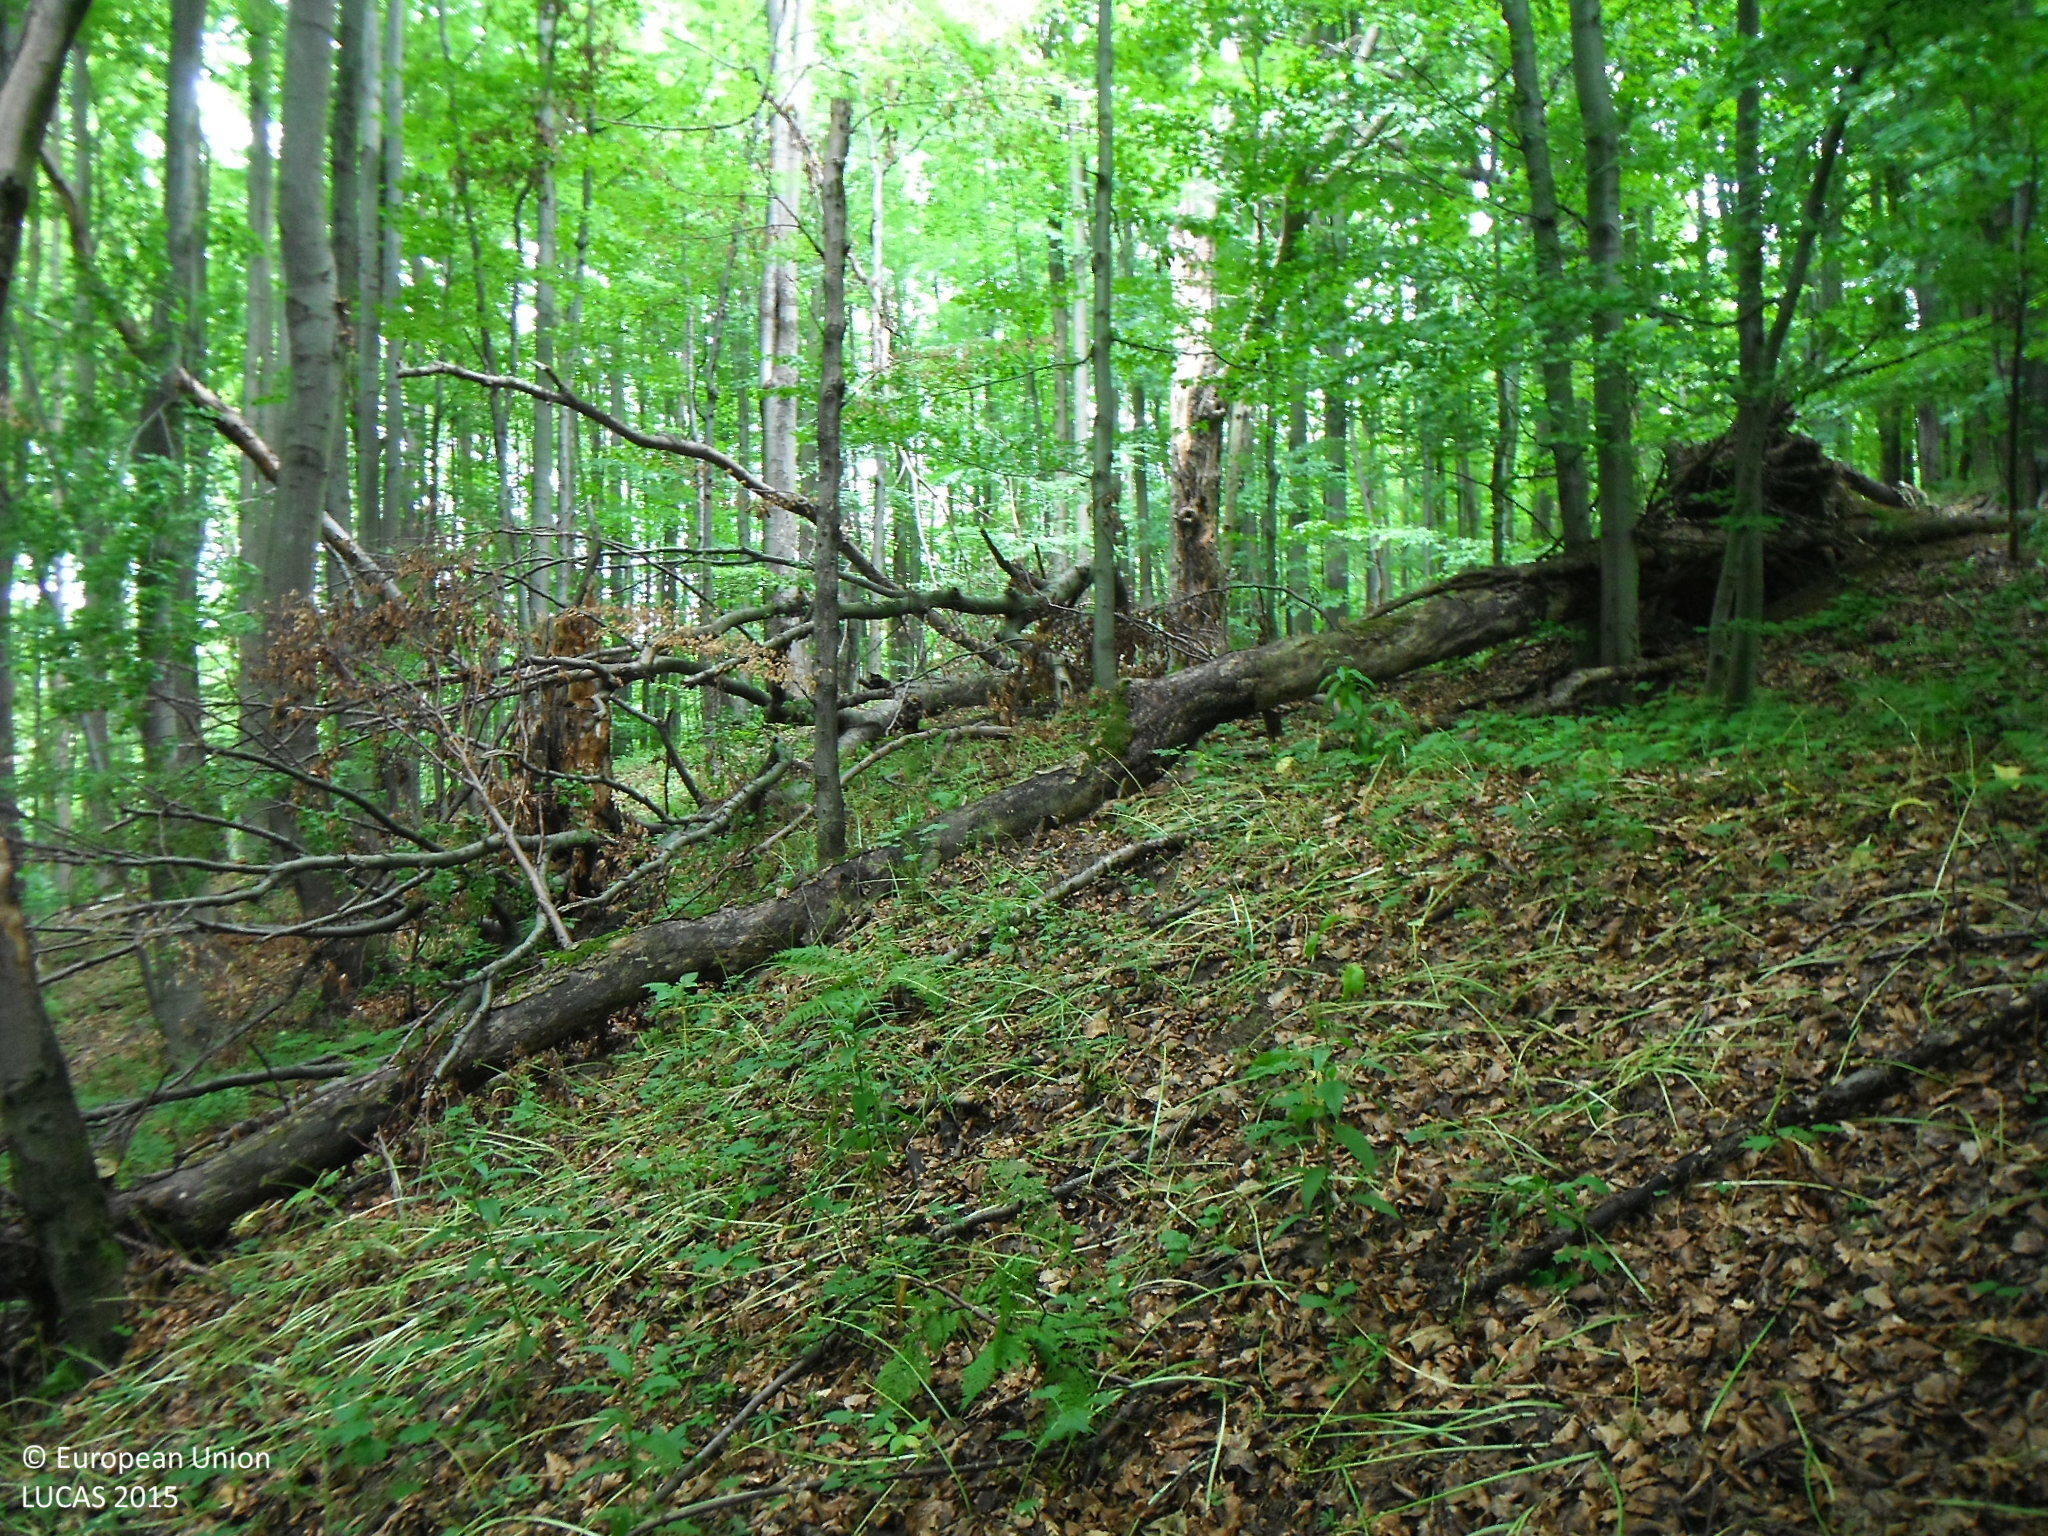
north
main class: Woodland
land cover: Broadleaved woodland
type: beech forest
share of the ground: > 75 %
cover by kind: broadleaved forest trees 100 %
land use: Forestry
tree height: > 5 m
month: July
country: SK
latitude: 49.3603
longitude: 21.8819
